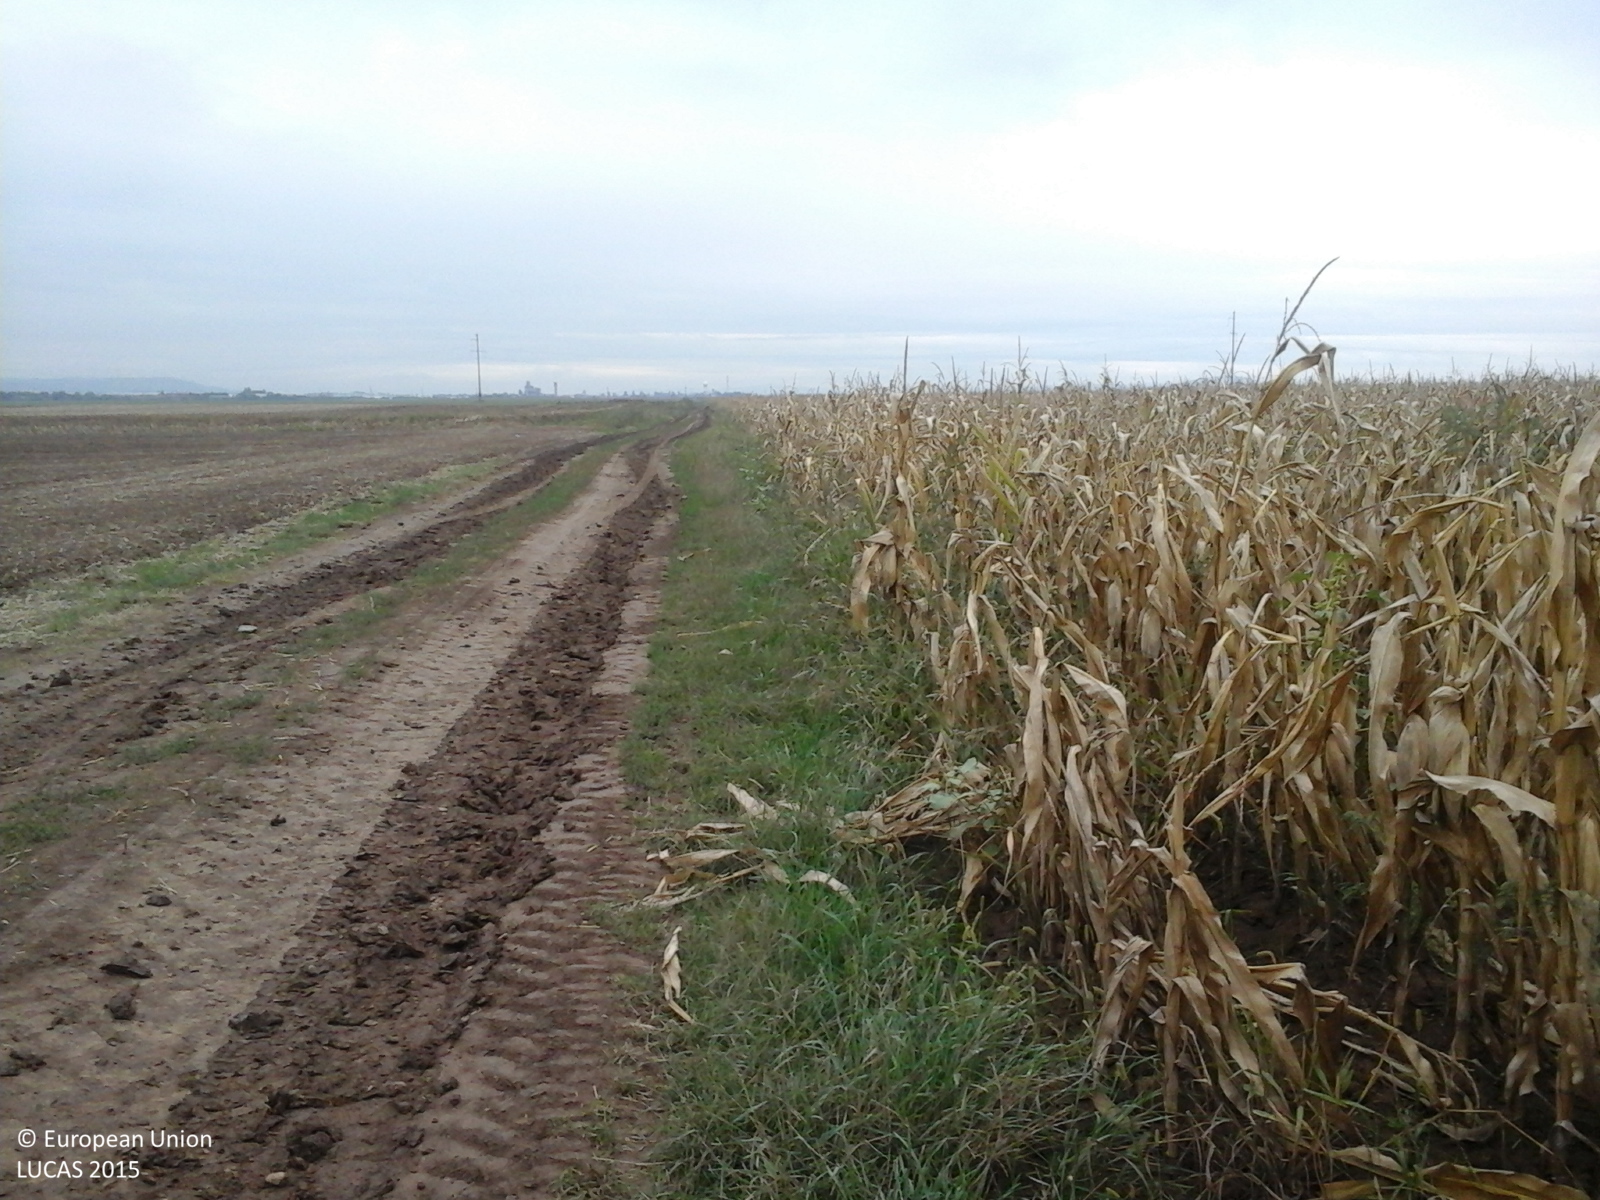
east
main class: Cropland
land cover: Maize
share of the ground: > 75 %
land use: Agriculture (excluding fallow land and kitchen gardens)
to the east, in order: Maize; Electric lines; Maize
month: September
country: RO
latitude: 47.0362
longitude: 21.8497
